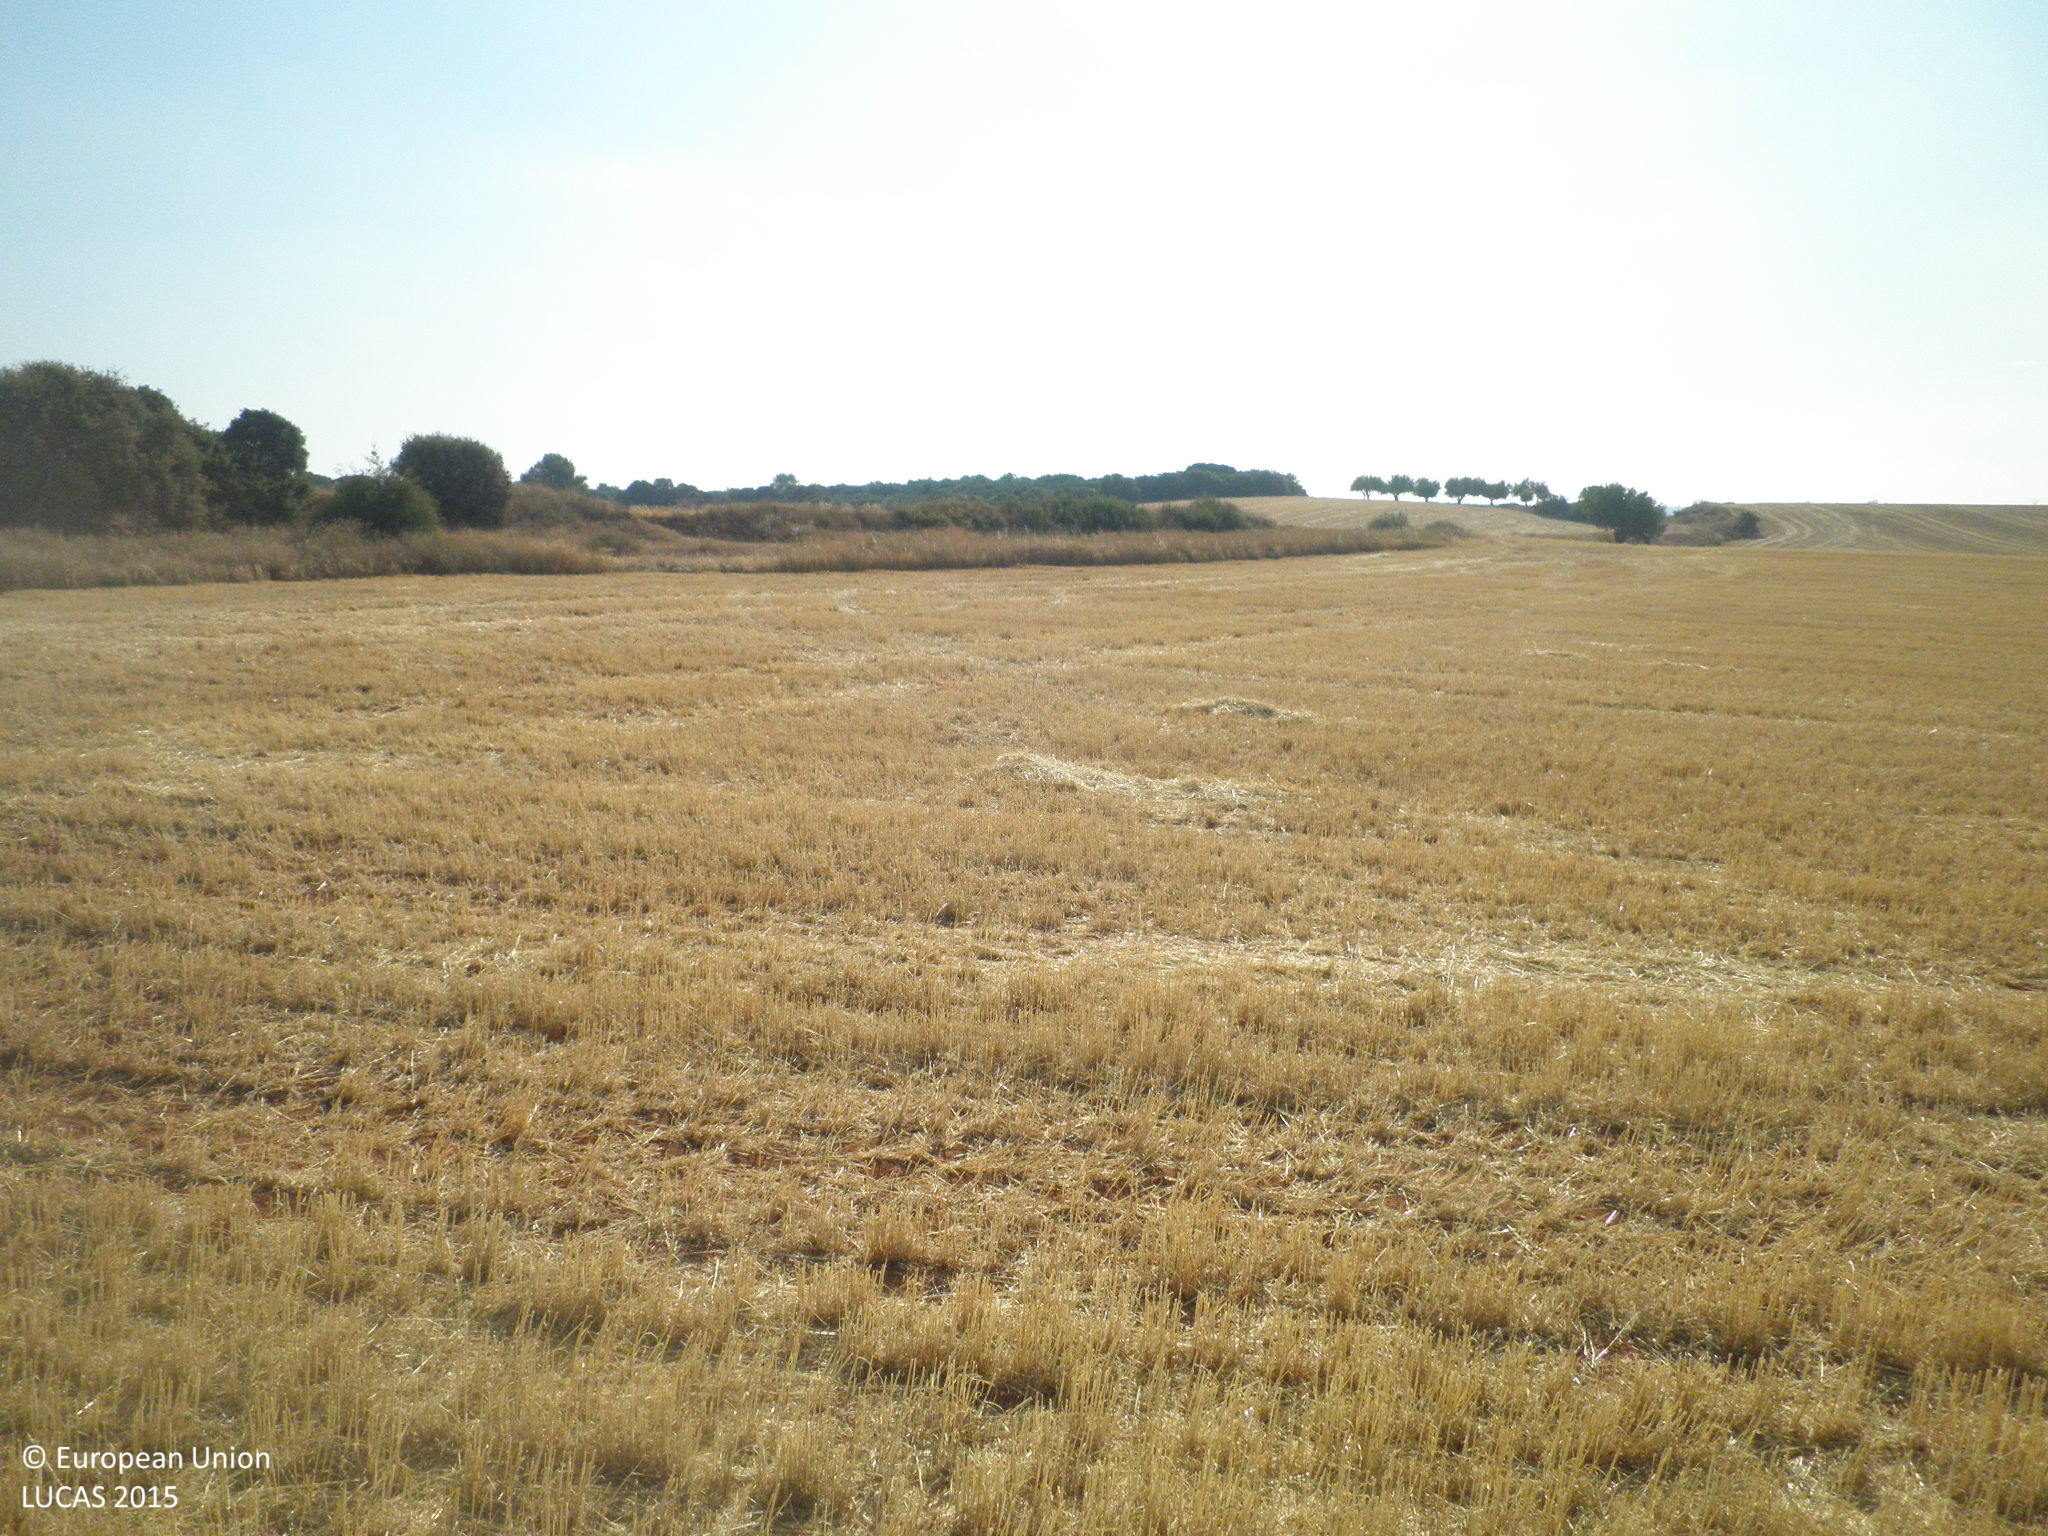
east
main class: Cropland
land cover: Barley
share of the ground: < 10 %
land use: Agriculture (excluding fallow land and kitchen gardens)
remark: Harvested field
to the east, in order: Barley; Grassland without tree/shrub cover; Tracks; Shruby margins; Dry stone walls; Barley; Grass margins; Barley; Grass margins; Barley
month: July
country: ES
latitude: 39.6039
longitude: -1.8286
